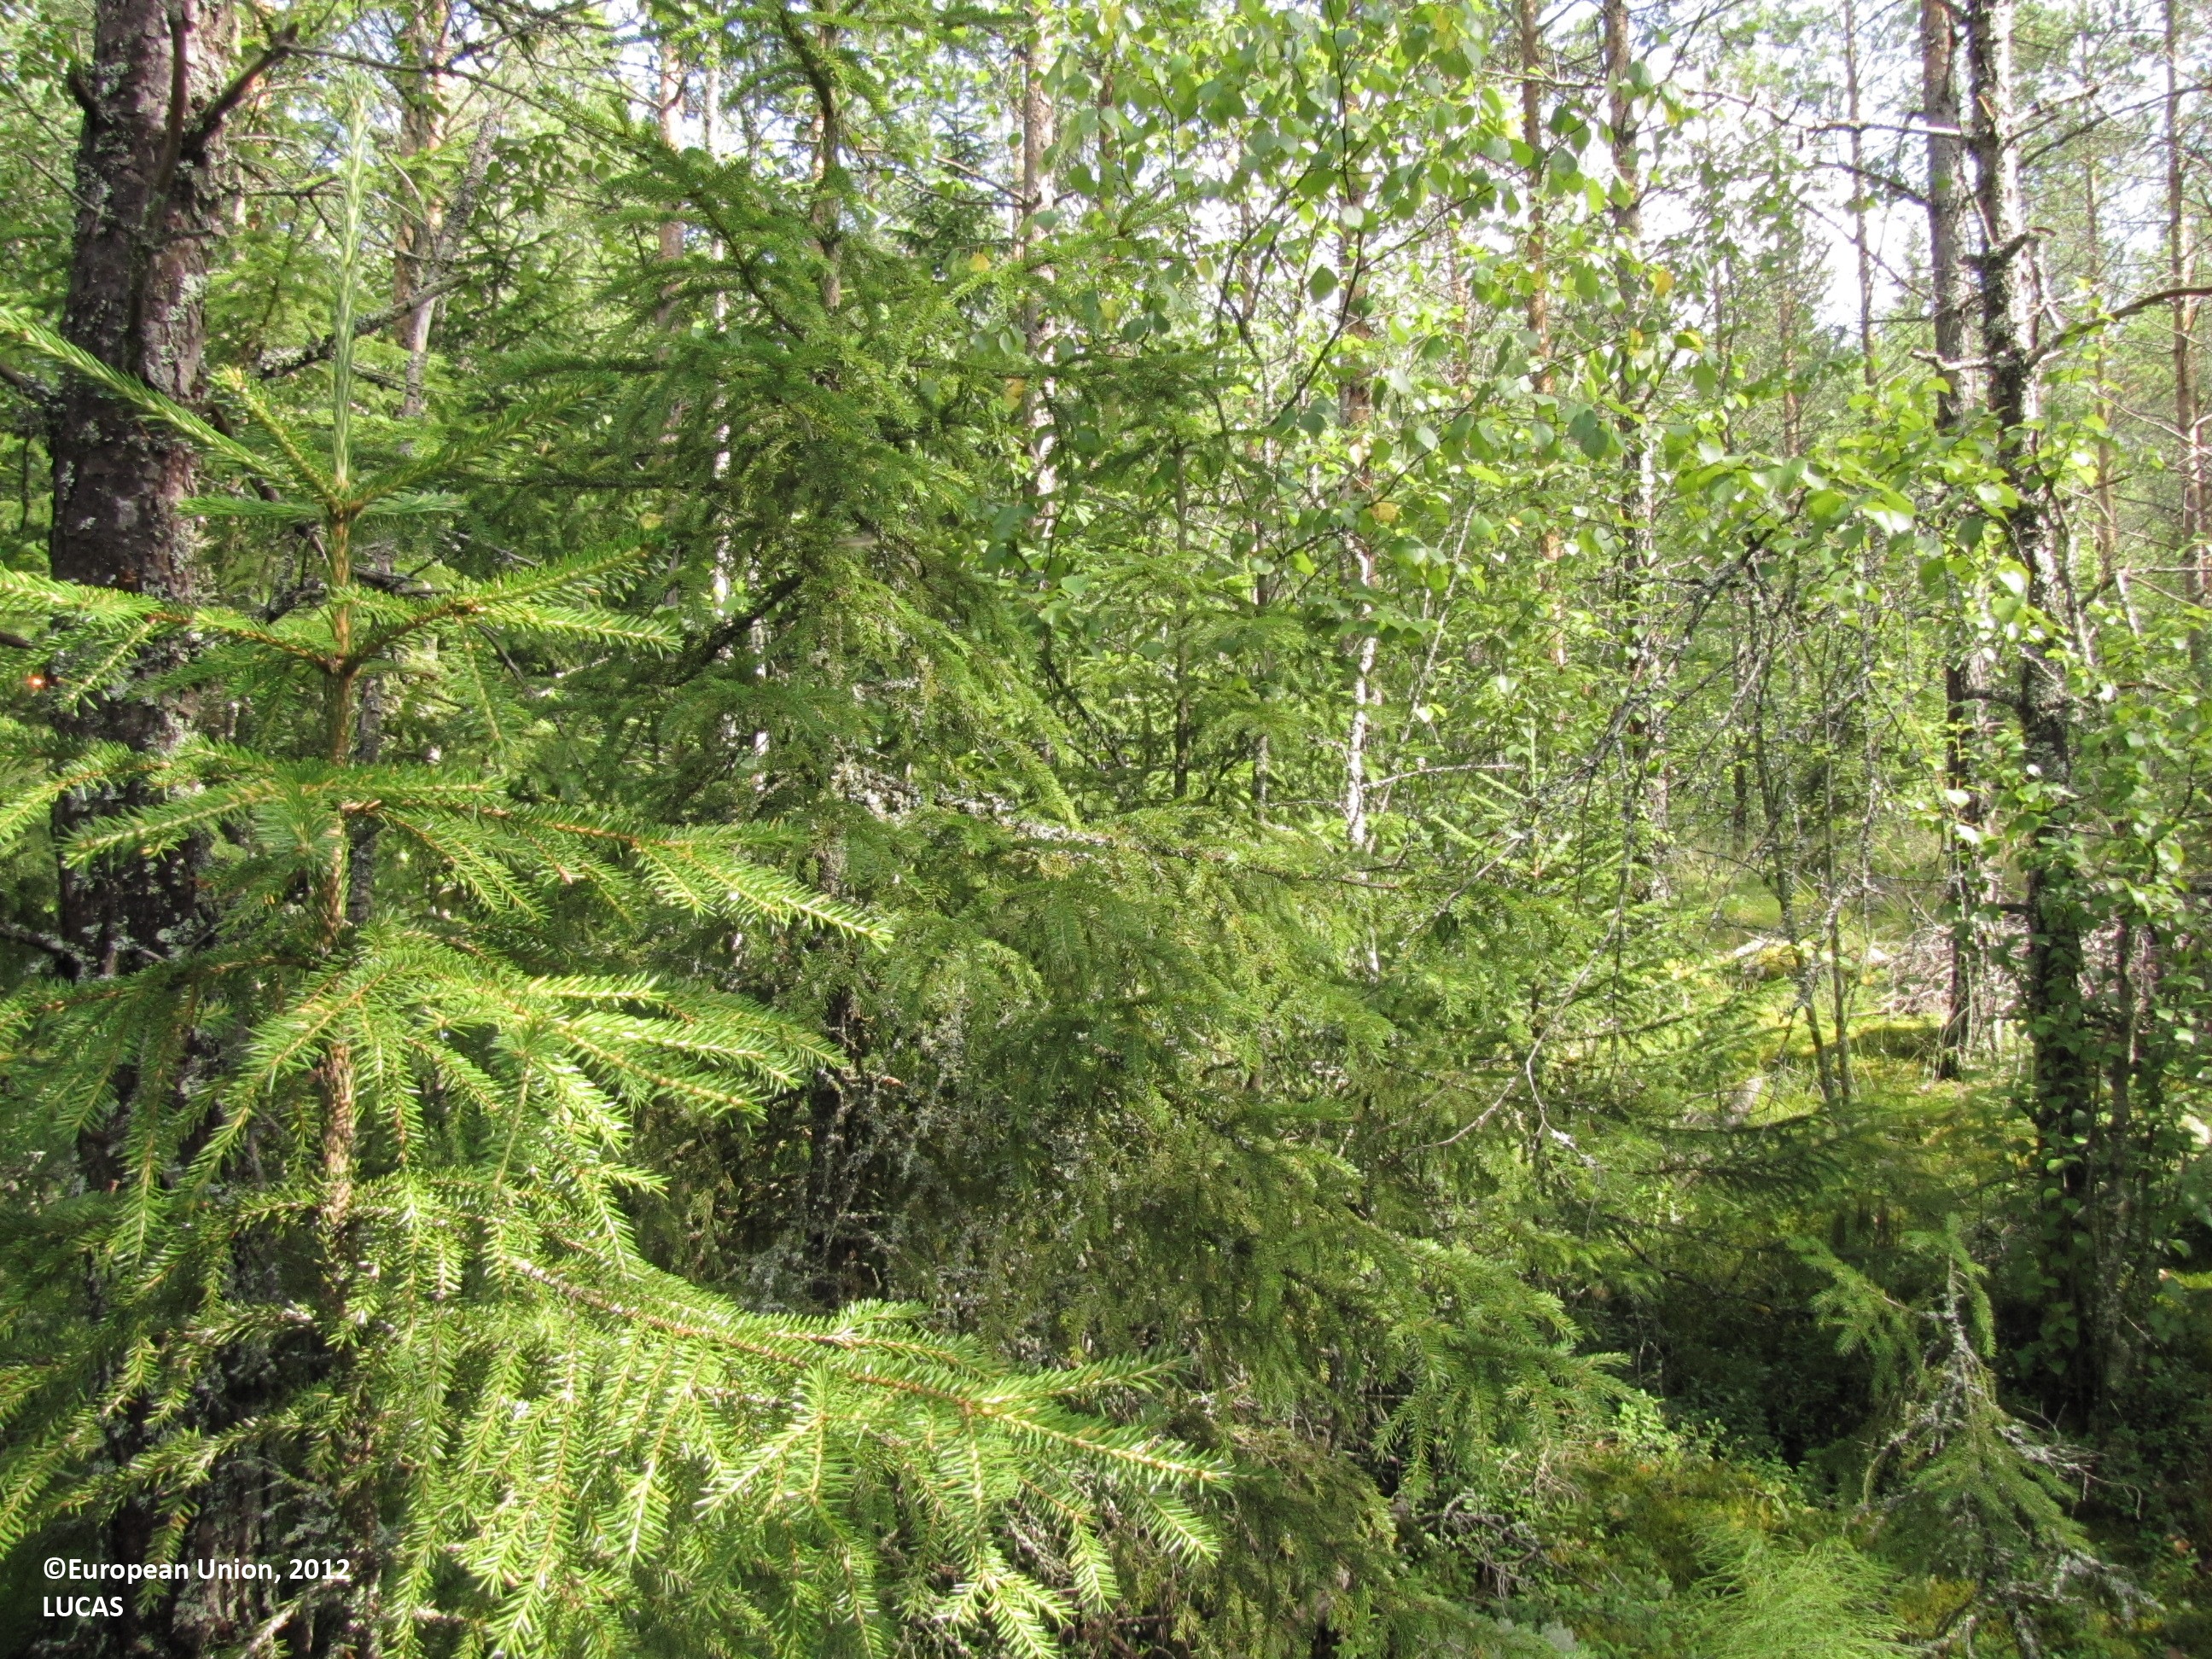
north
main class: Woodland
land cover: Other coniferous woodland
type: boreal forest
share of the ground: 50 - 75 %
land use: Forestry
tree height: > 5 m
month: July
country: FI
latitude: 62.2389
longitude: 23.0953
